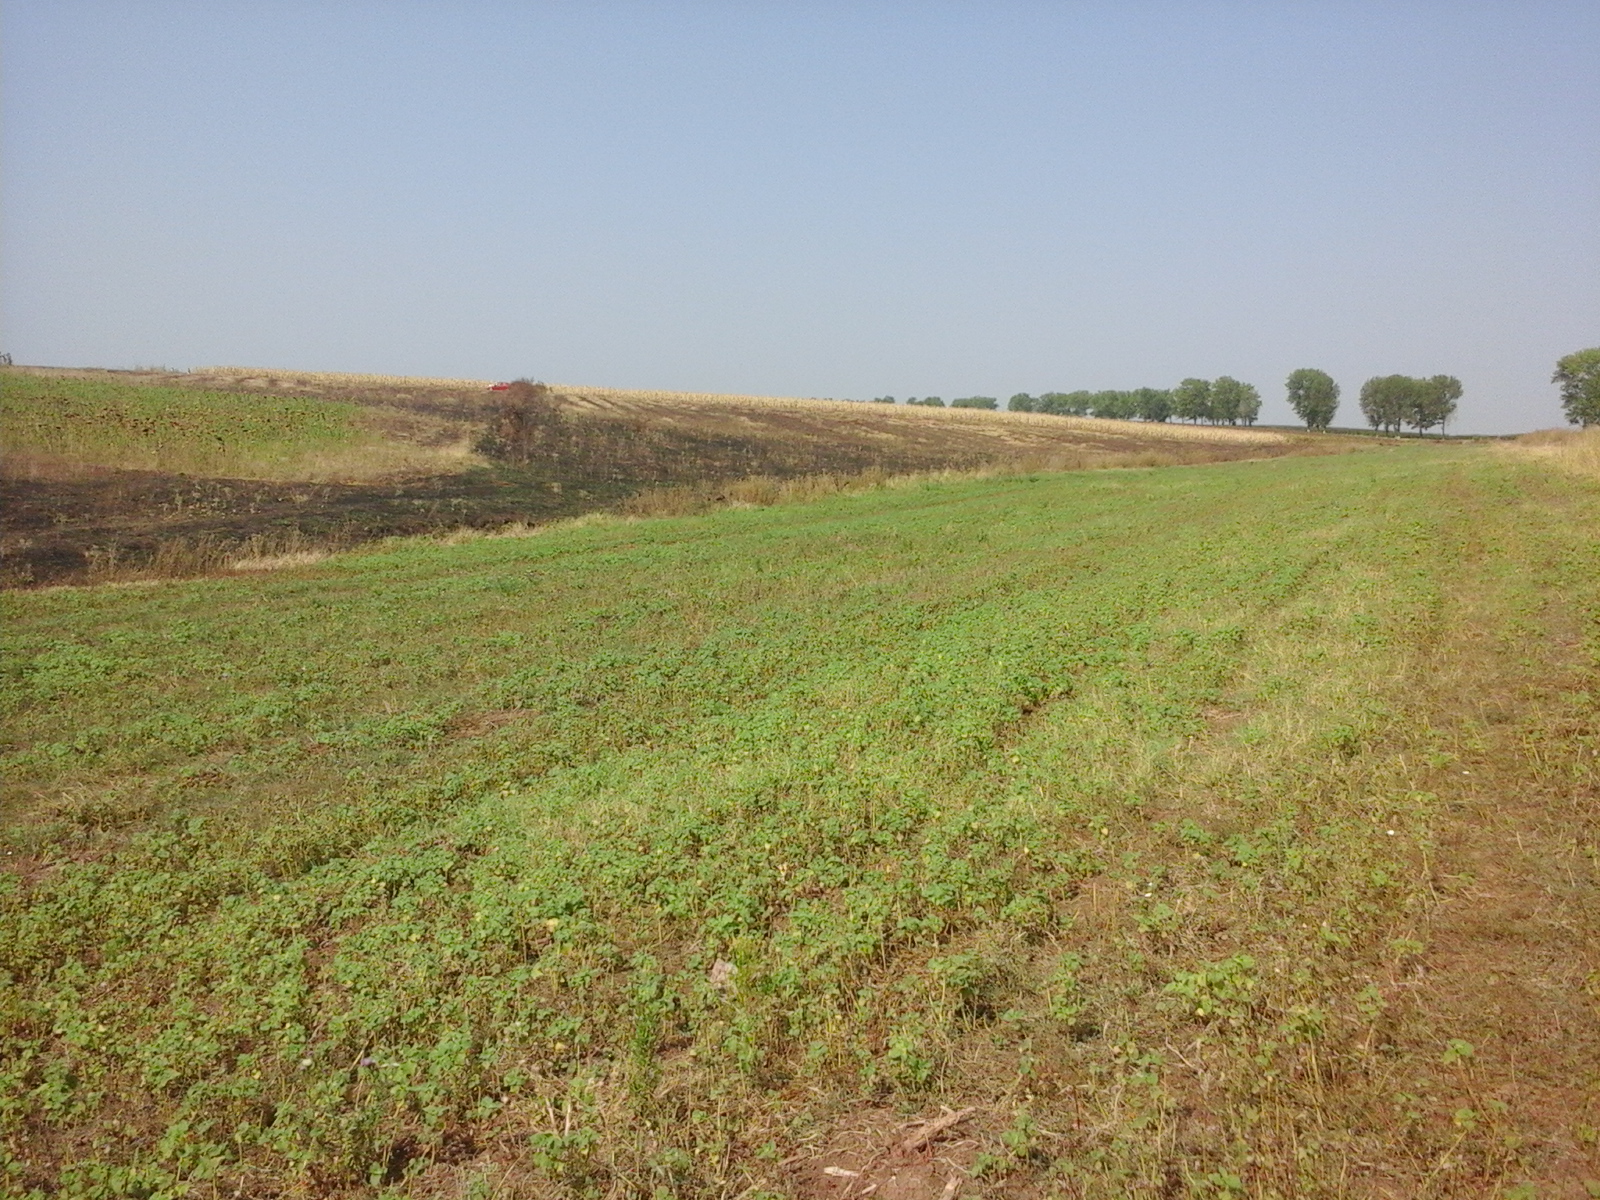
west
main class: Grassland
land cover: Spontaneously vegetated surfaces
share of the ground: > 75 %
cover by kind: herbaceous plants 100 %
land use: Fallow land
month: August
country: RO
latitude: 44.2023
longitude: 23.2994
